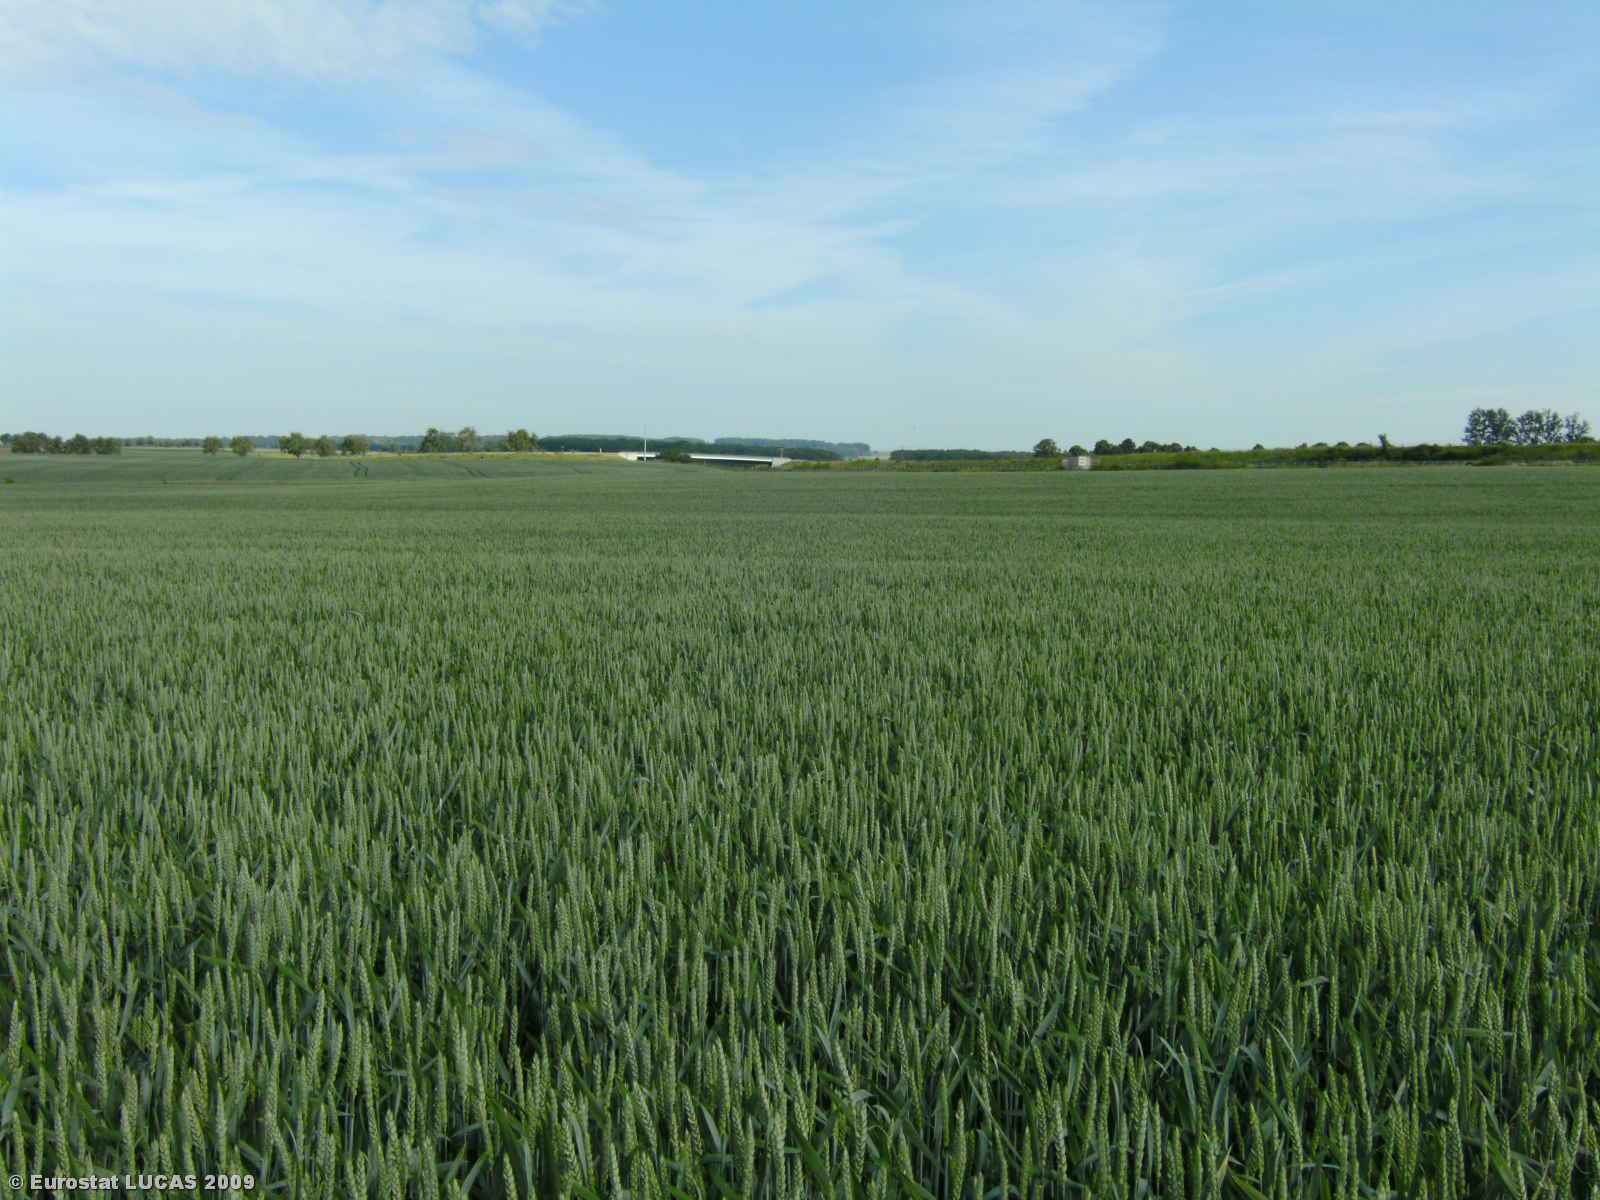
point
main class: Cropland
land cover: Common wheat
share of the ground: > 75 %
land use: Agriculture (excluding fallow land and kitchen gardens)
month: June
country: LU
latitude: 49.4946
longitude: 6.3134
